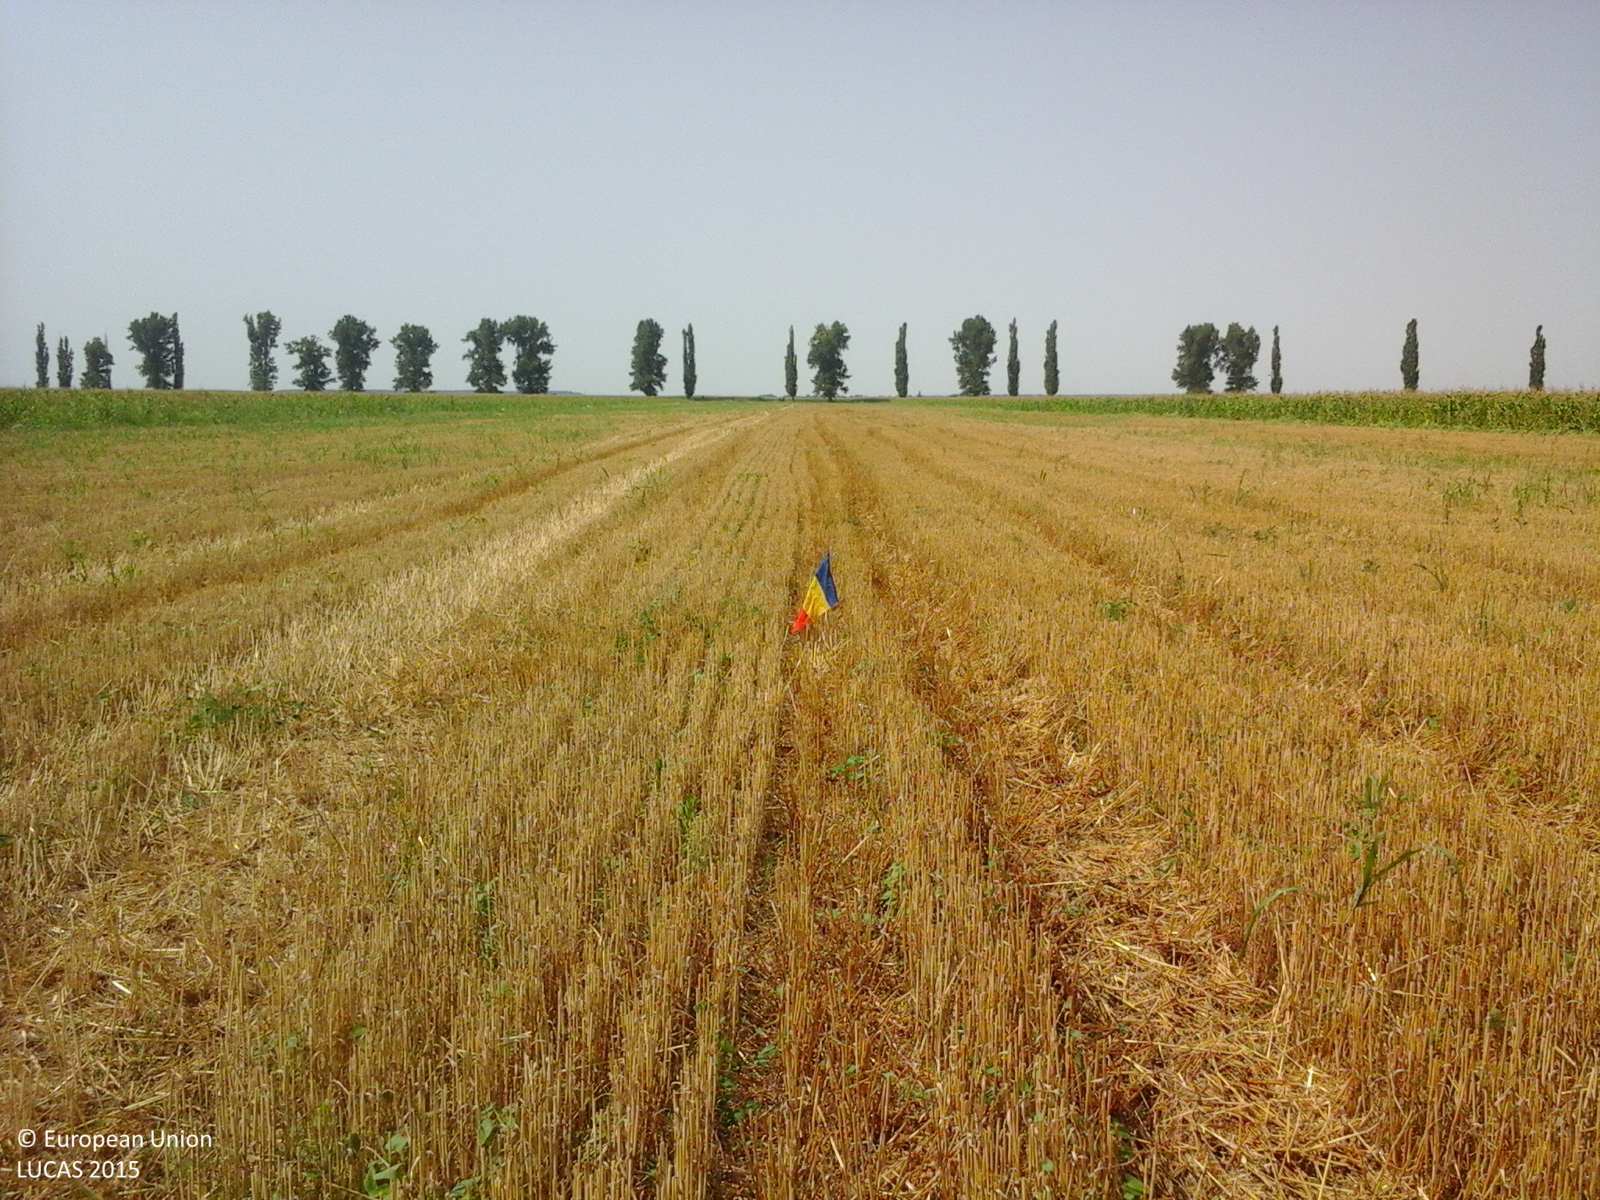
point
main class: Cropland
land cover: Durum wheat
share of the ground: 25 - 50 %
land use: Agriculture (excluding fallow land and kitchen gardens)
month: July
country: RO
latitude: 44.6331
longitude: 26.5175
